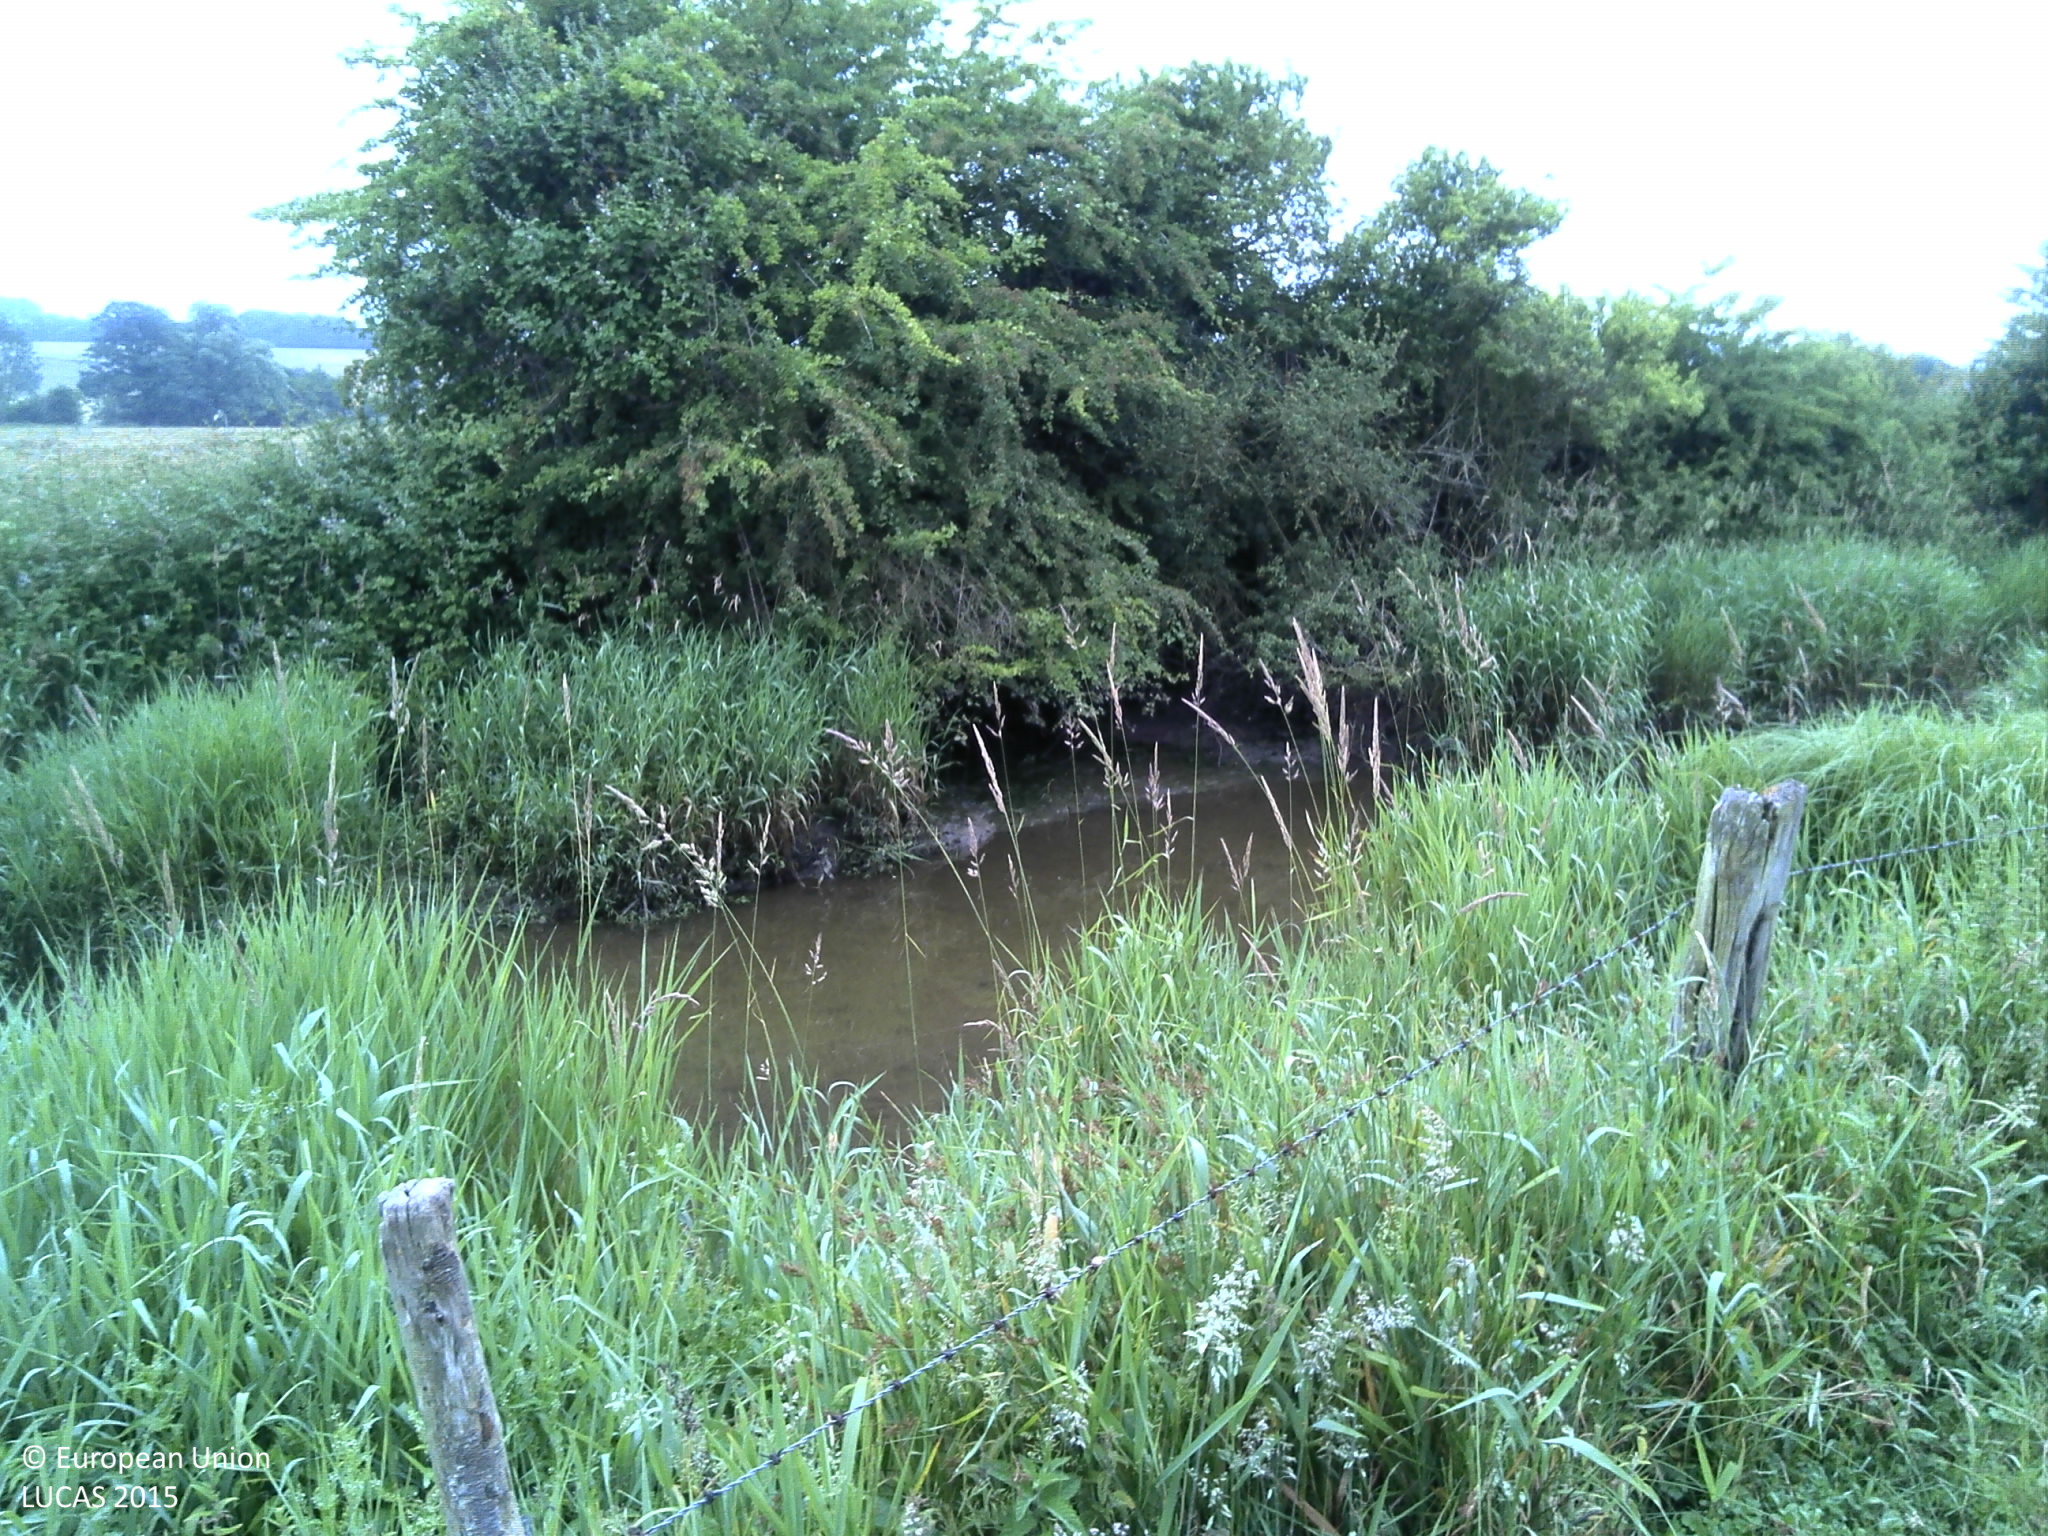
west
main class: Grassland
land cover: Grassland without tree/shrub cover
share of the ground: > 75 %
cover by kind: herbaceous plants 100 %
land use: Agriculture (excluding fallow land and kitchen gardens)
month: July
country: FR
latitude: 49.8955
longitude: 0.9421
